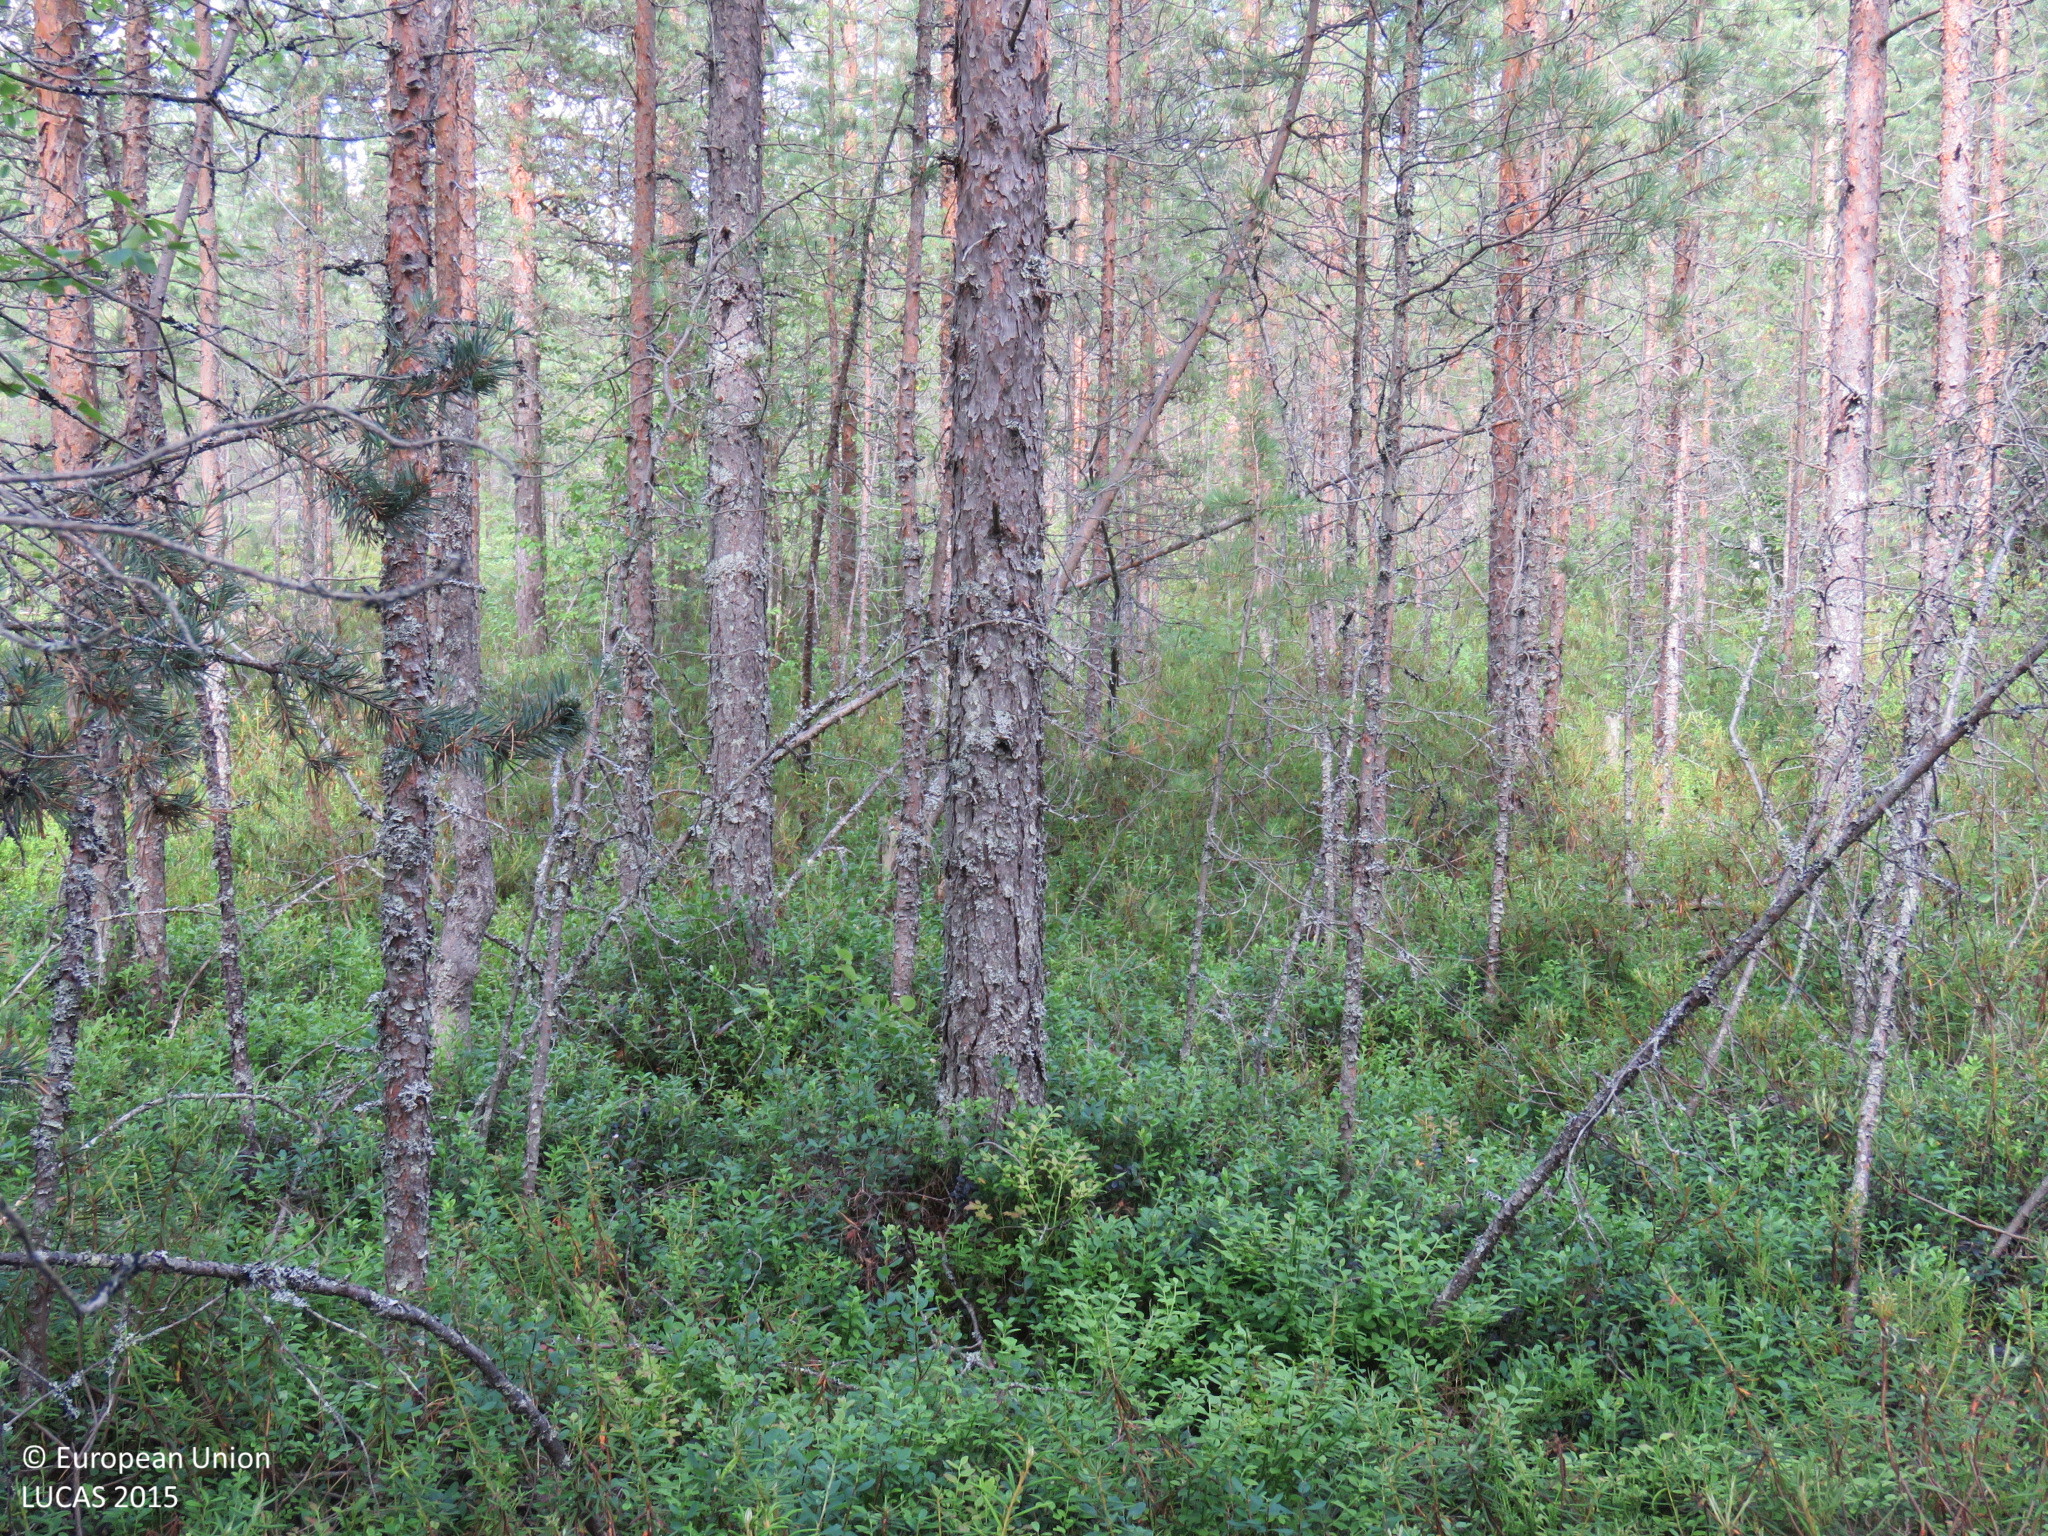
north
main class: Woodland
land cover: Pine dominated coniferous woodland
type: boreal forest
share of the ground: > 75 %
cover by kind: coniferous forest trees 70 %, shrubs 15 %, broadleaved forest trees 10 %, lichens and mosses 5 %
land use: Forestry
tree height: > 5 m
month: July
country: FI
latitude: 64.8395
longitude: 25.7975
